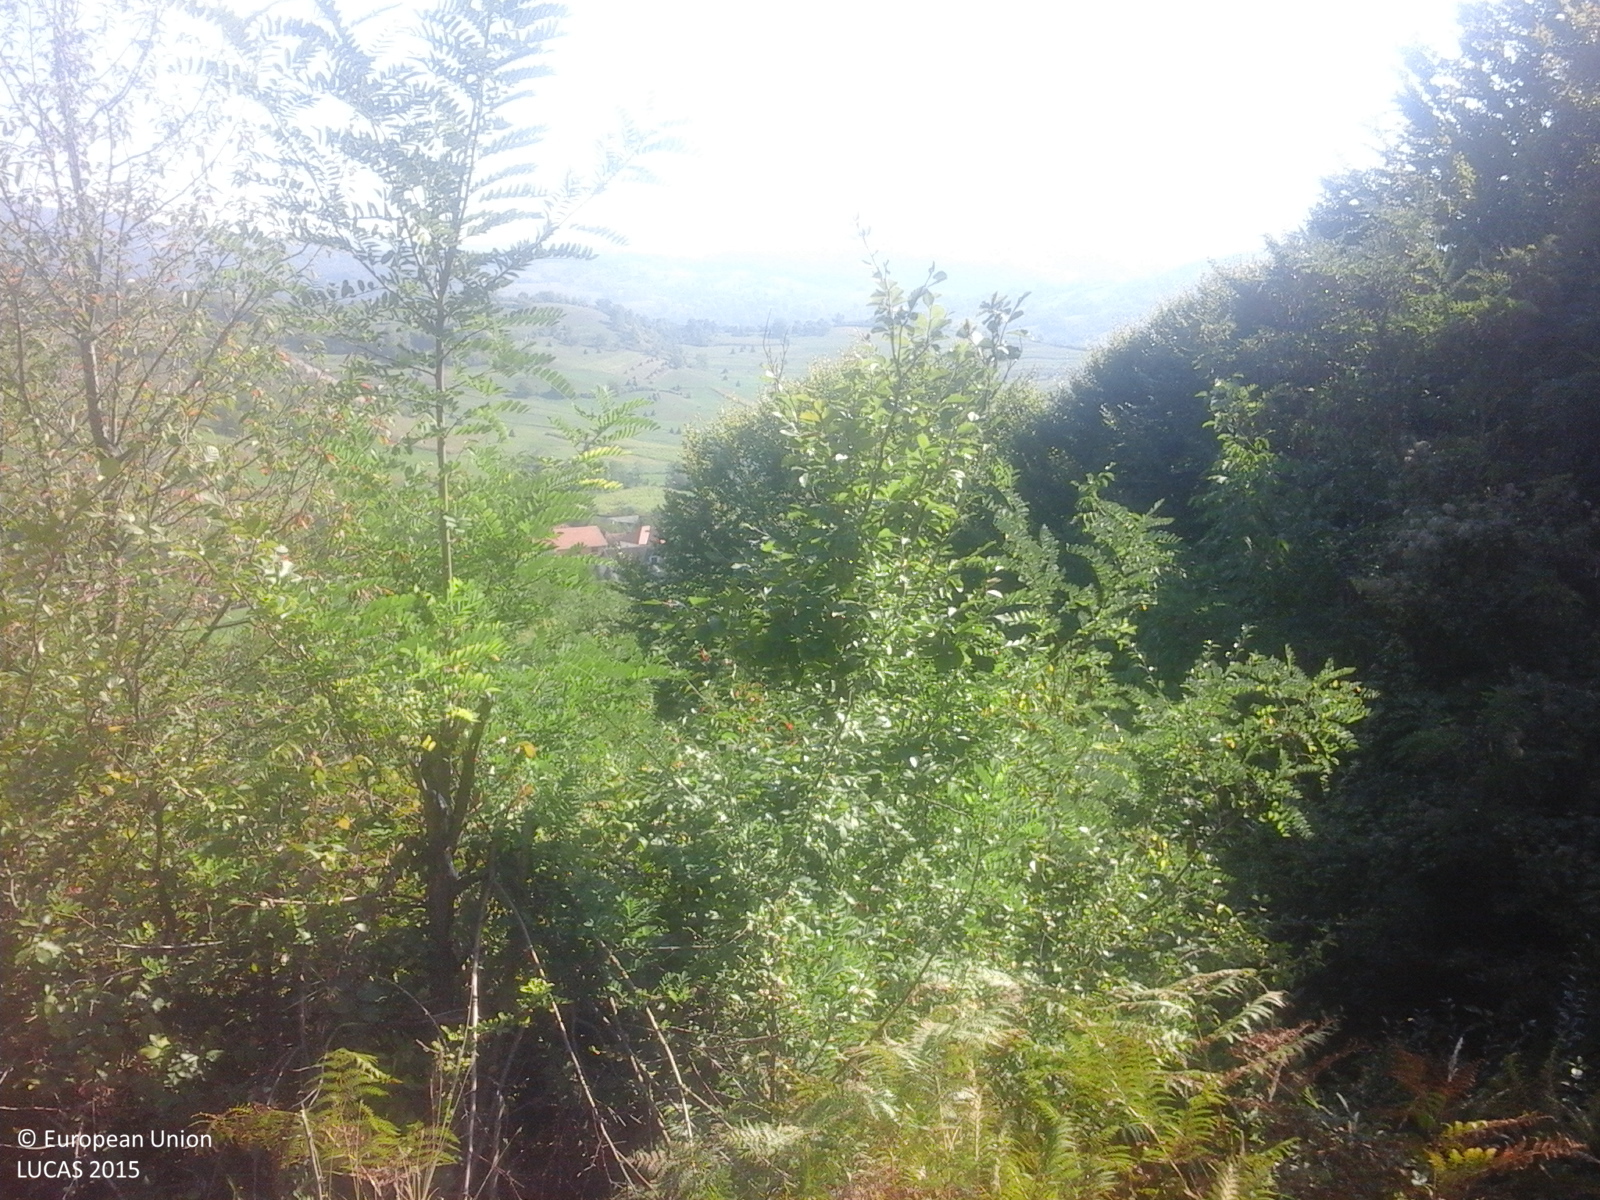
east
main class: Grassland
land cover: Grassland without tree/shrub cover
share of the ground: > 75 %
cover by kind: herbaceous plants 100 %
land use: Agriculture (excluding fallow land and kitchen gardens)
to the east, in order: Grassland without tree/shrub cover; Broadleaved woodland; Grassland with sparse tree/shrub cover; Fences; Other fruit trees and berries; Maize; Lucerne; Maize; Other fruit trees and berries
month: September
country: RO
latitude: 46.8121
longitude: 22.3836
